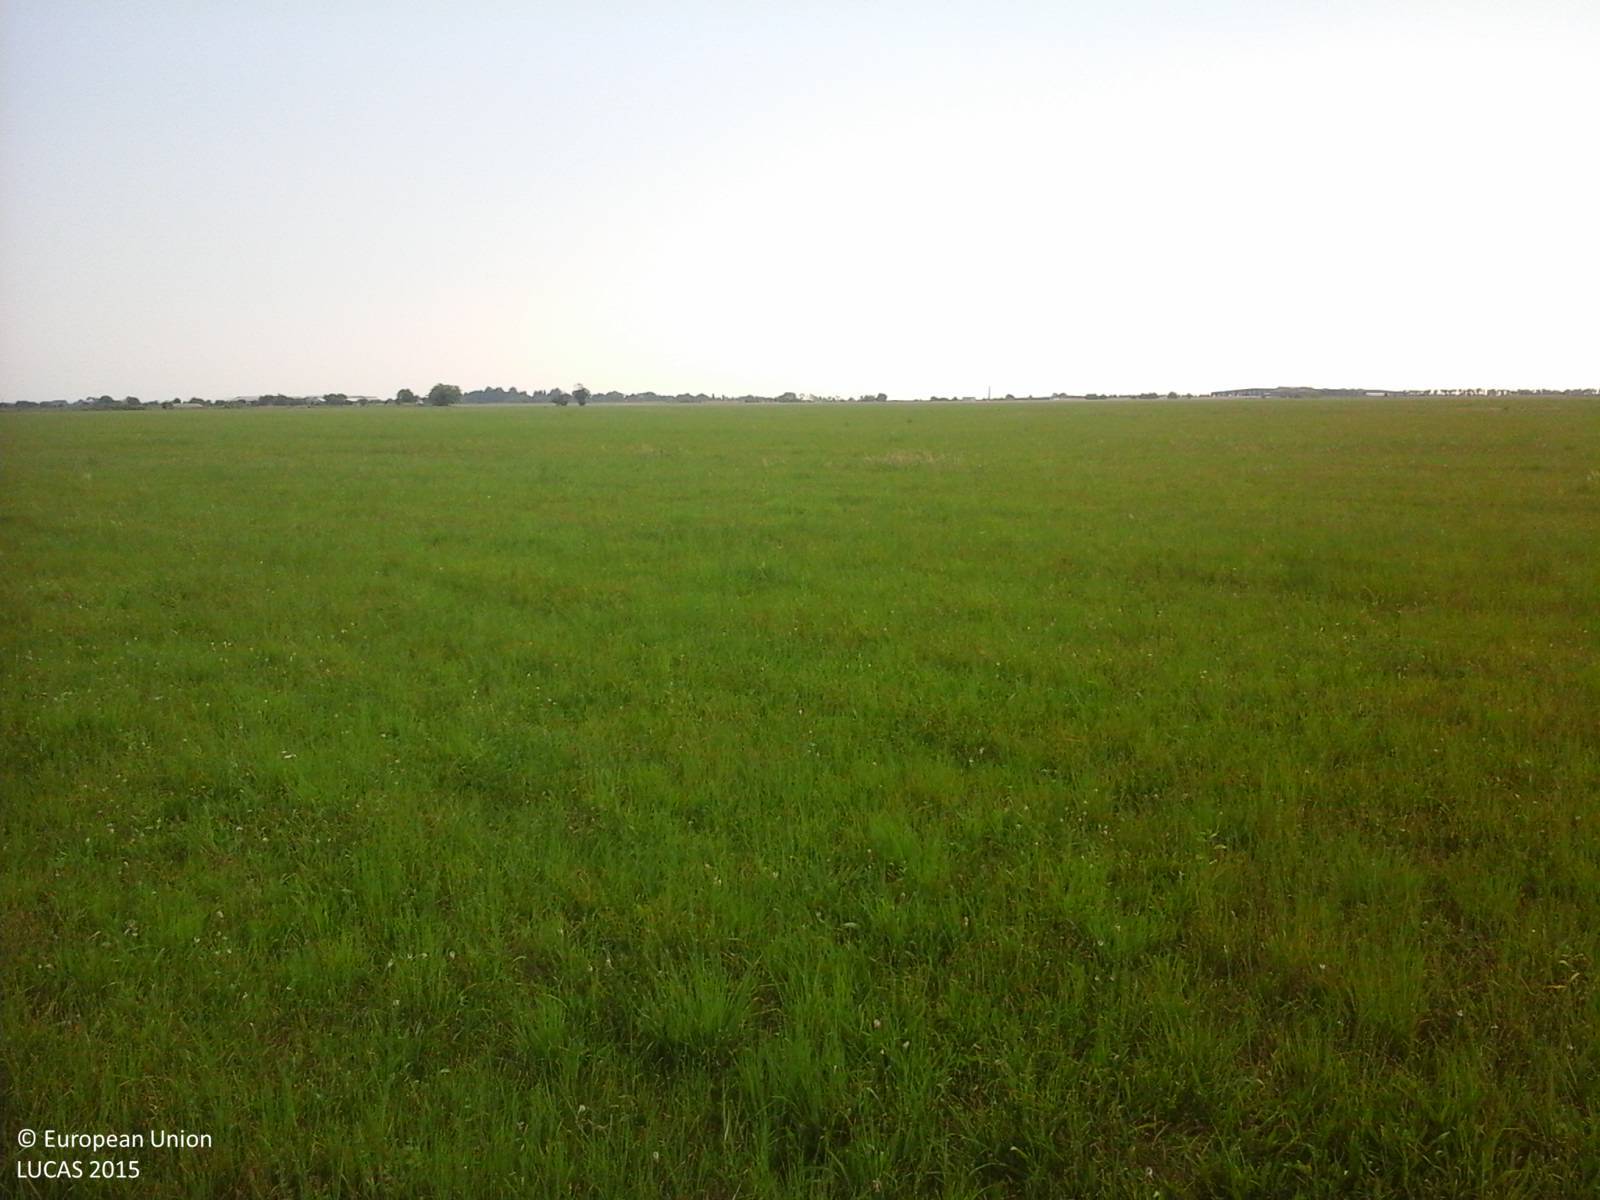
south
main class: Grassland
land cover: Grassland without tree/shrub cover
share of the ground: > 75 %
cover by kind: herbaceous plants 100 %
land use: Agriculture (excluding fallow land and kitchen gardens)
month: June
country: IT
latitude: 46.1362
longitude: 12.7280
